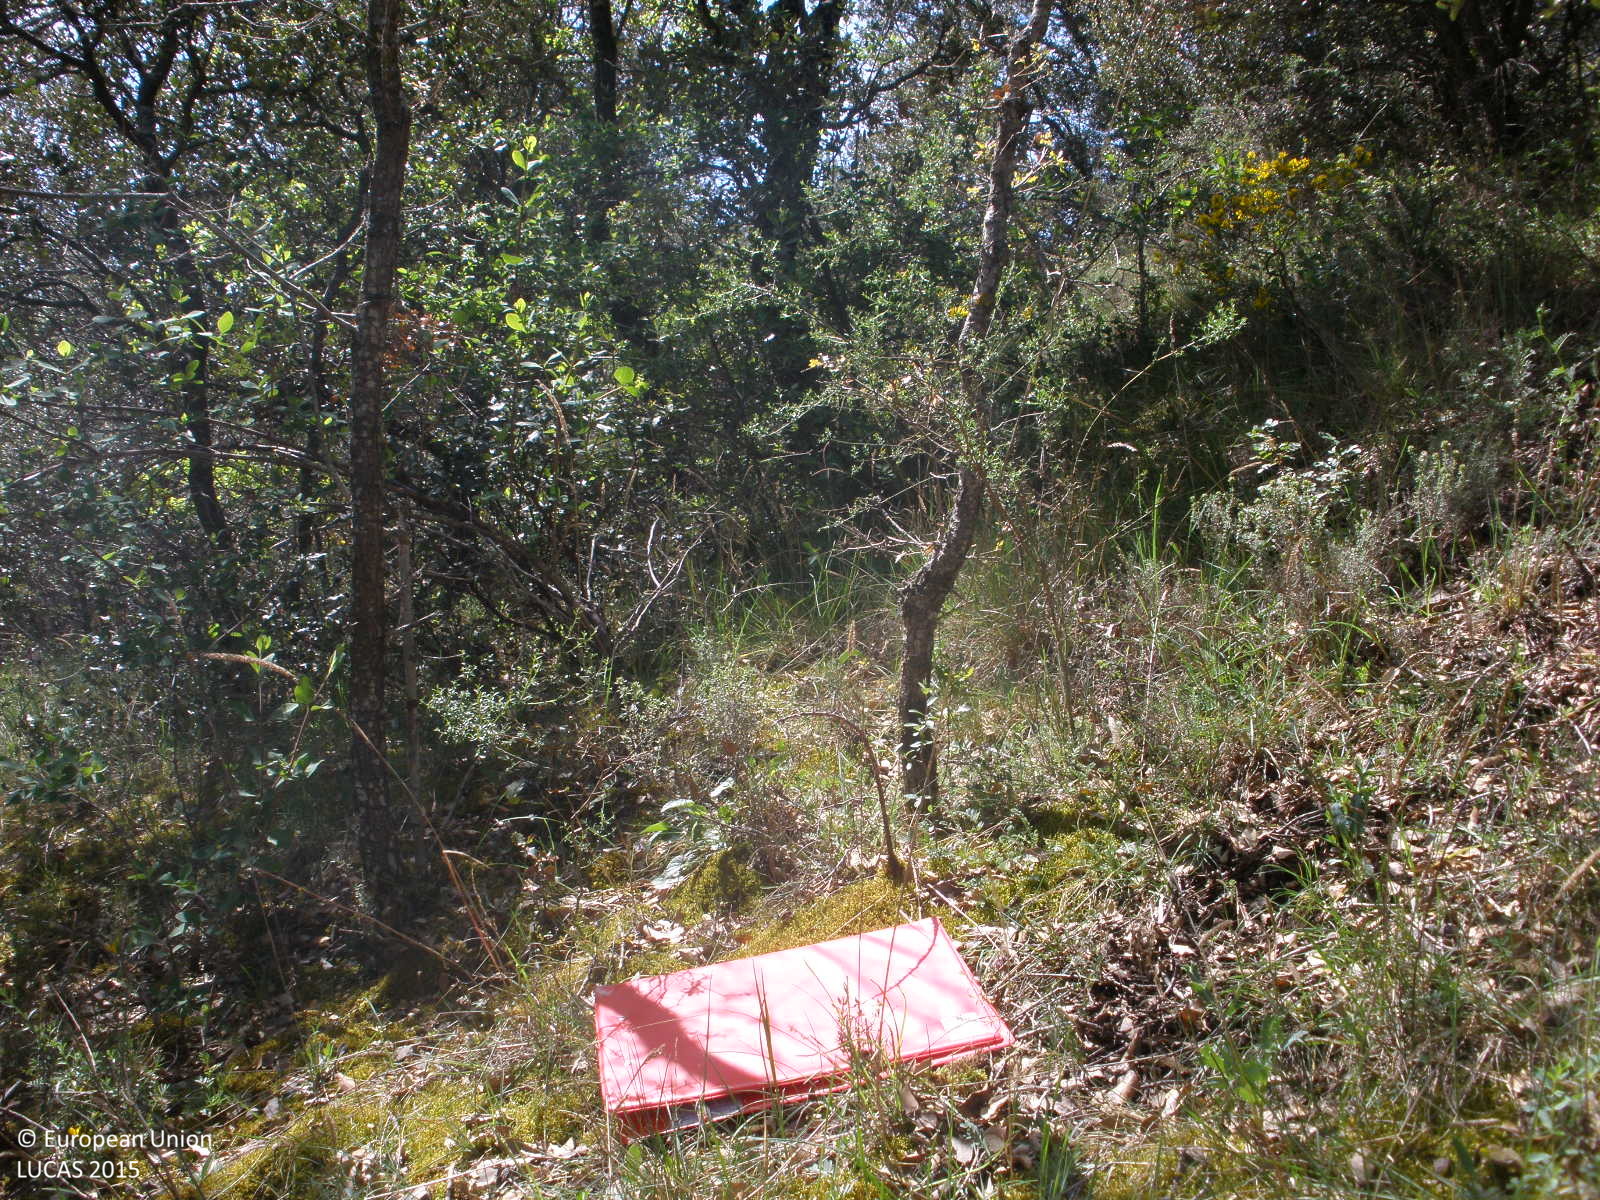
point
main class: Woodland
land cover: Broadleaved woodland
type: broadleaved evergreen forest
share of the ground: > 75 %
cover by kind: broadleaved forest trees 90 %, shrubs 5 %, herbaceous plants 5 %
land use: Semi-natural and natural areas not in use
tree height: < 5 m
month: May
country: ES
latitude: 40.9186
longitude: -0.8795
